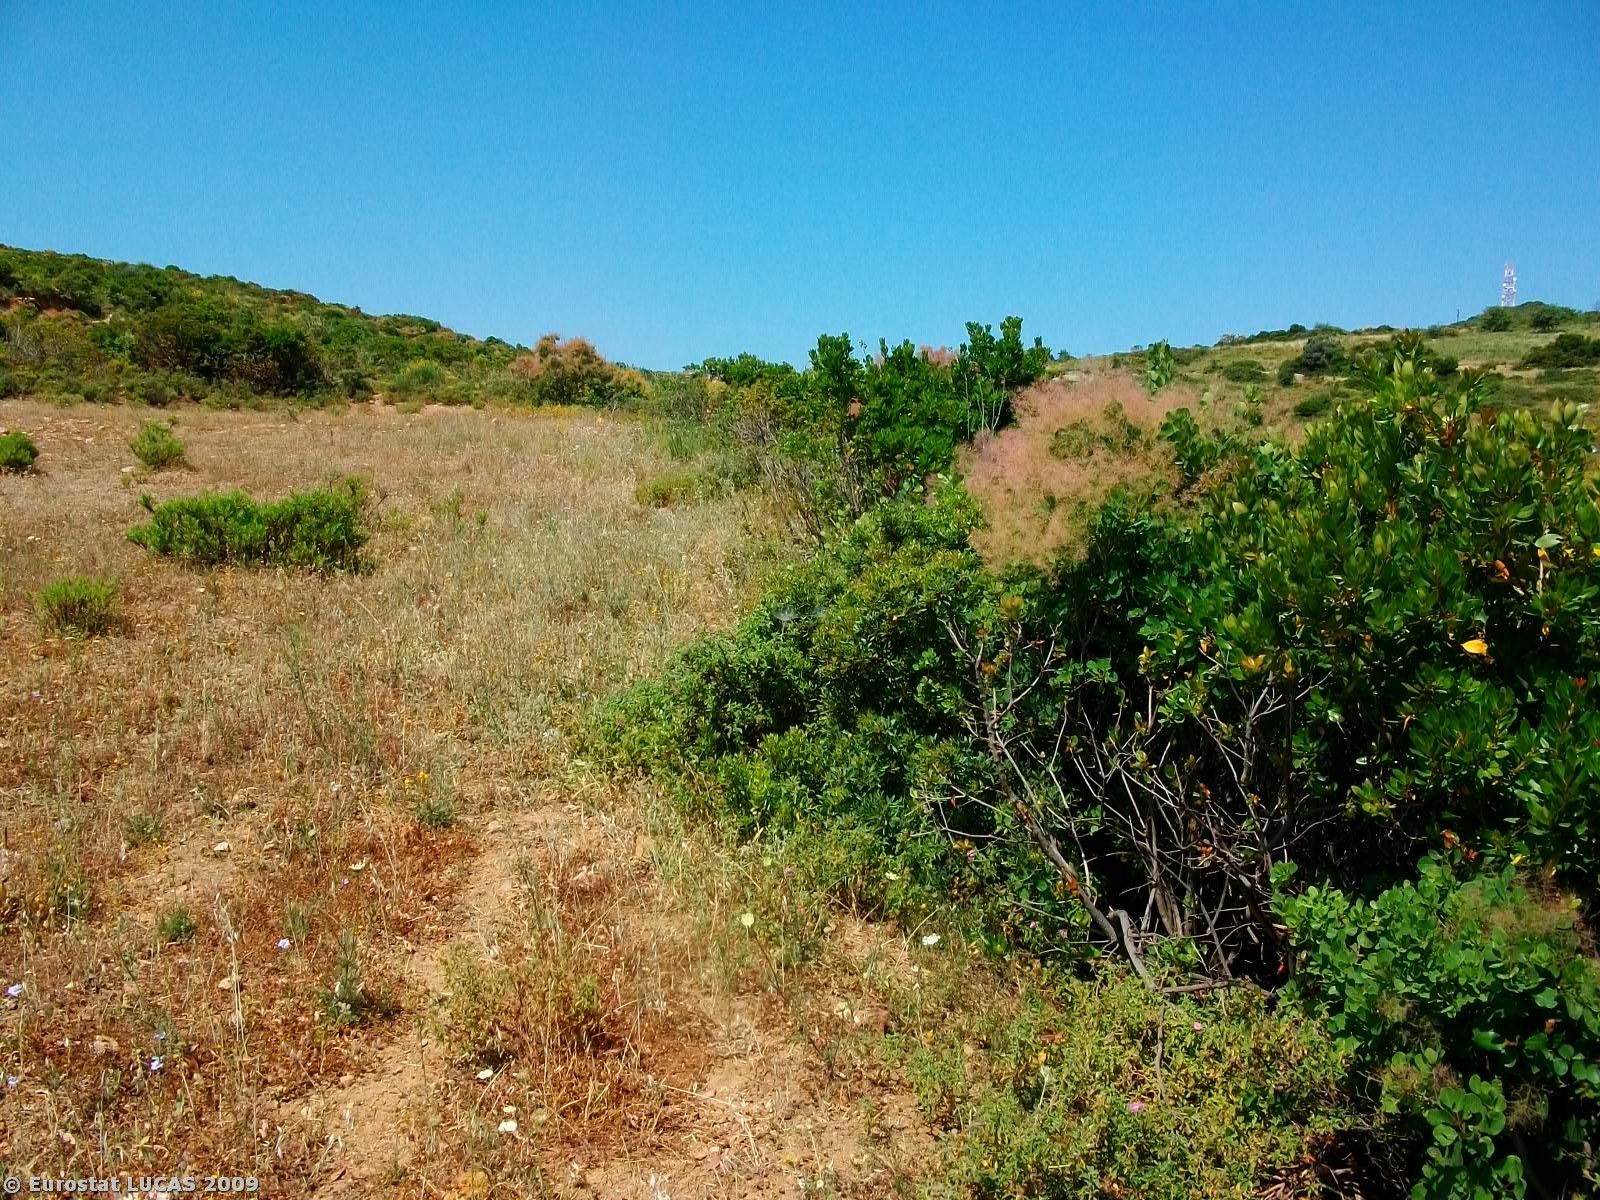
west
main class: Shrubland
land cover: Shrubland without tree cover
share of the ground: > 75 %
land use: Unused
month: June
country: GR
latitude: 39.2350
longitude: 23.2580
